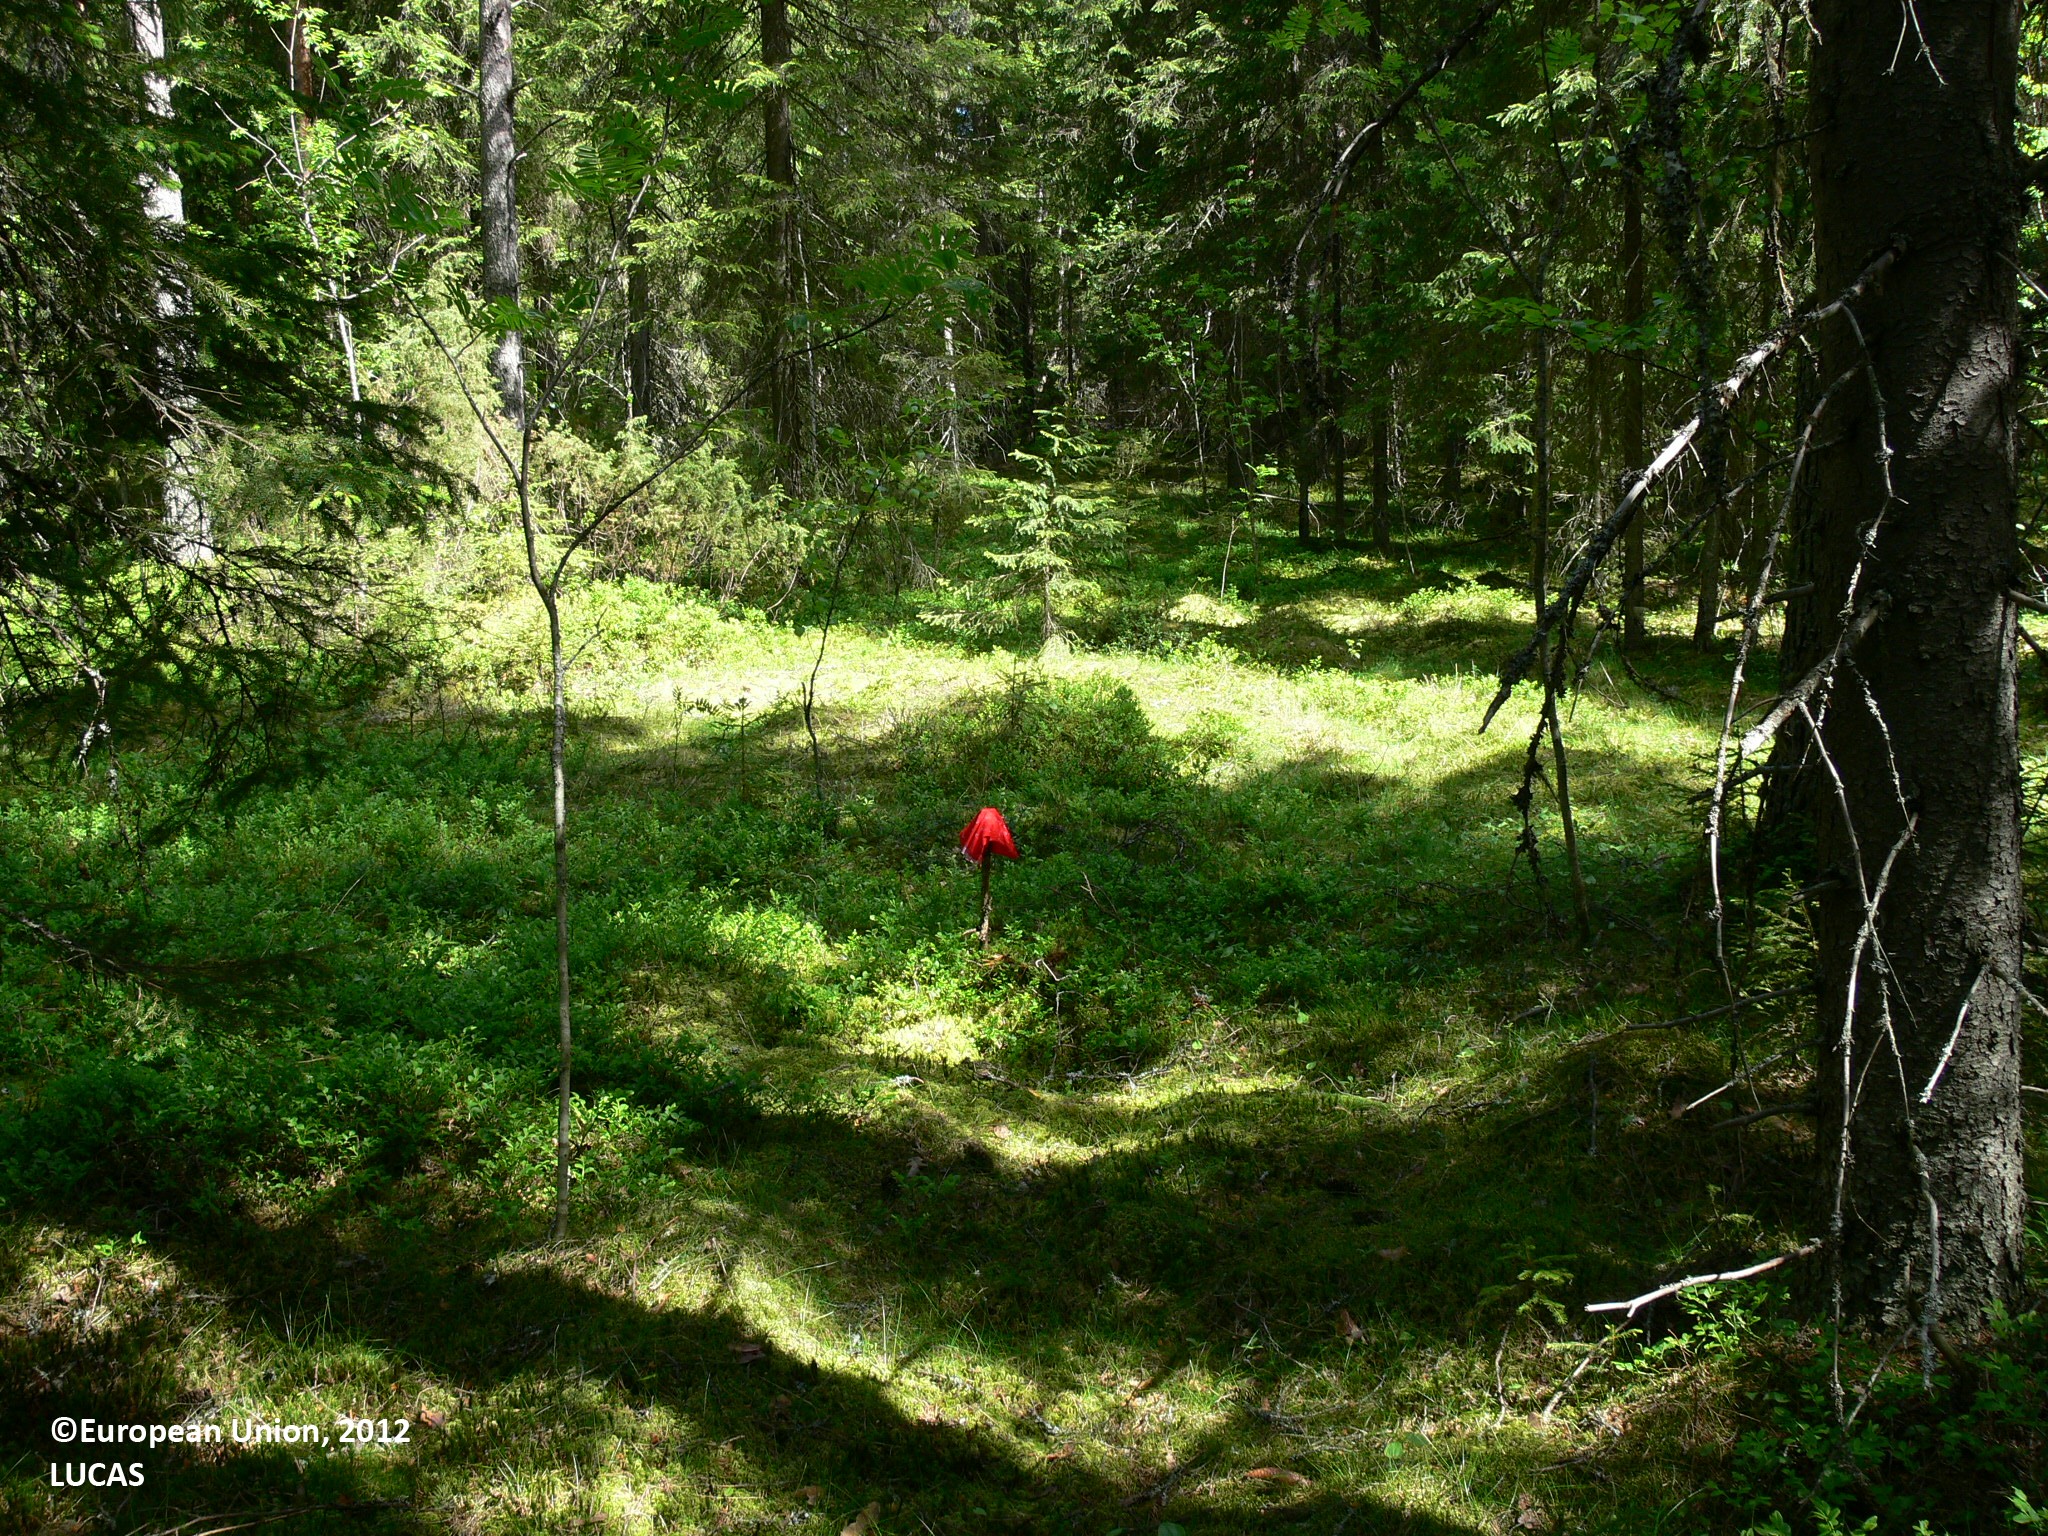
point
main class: Woodland
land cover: Spruce dominated coniferous woodland
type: boreal forest
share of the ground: > 75 %
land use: Forestry
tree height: > 5 m
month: June
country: FI
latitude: 62.5658
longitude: 30.6180
